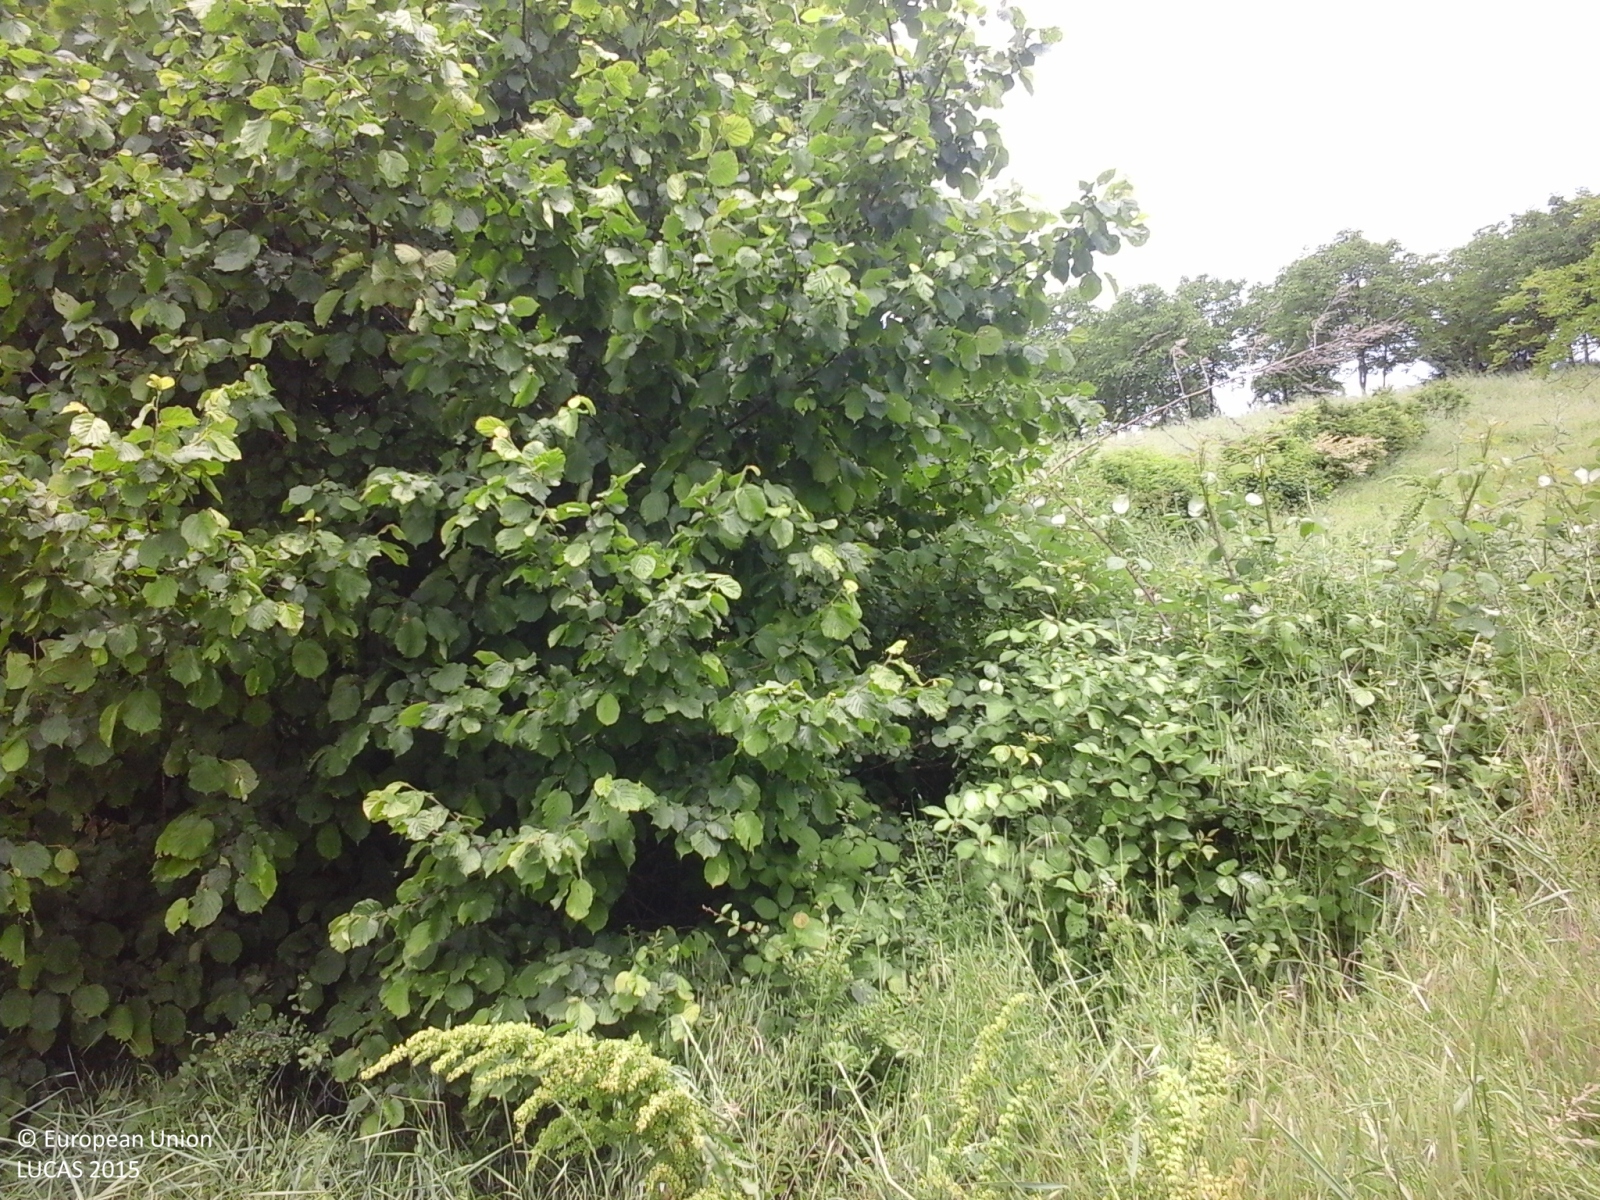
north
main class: Grassland
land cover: Grassland with sparse tree/shrub cover
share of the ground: > 75 %
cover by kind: herbaceous plants 85 %, shrubs 10 %, broadleaved forest trees 5 %
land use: Agriculture (excluding fallow land and kitchen gardens)
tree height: < 5 m
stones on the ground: < 10 %
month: May
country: IT
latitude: 44.8227
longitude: 8.2455
